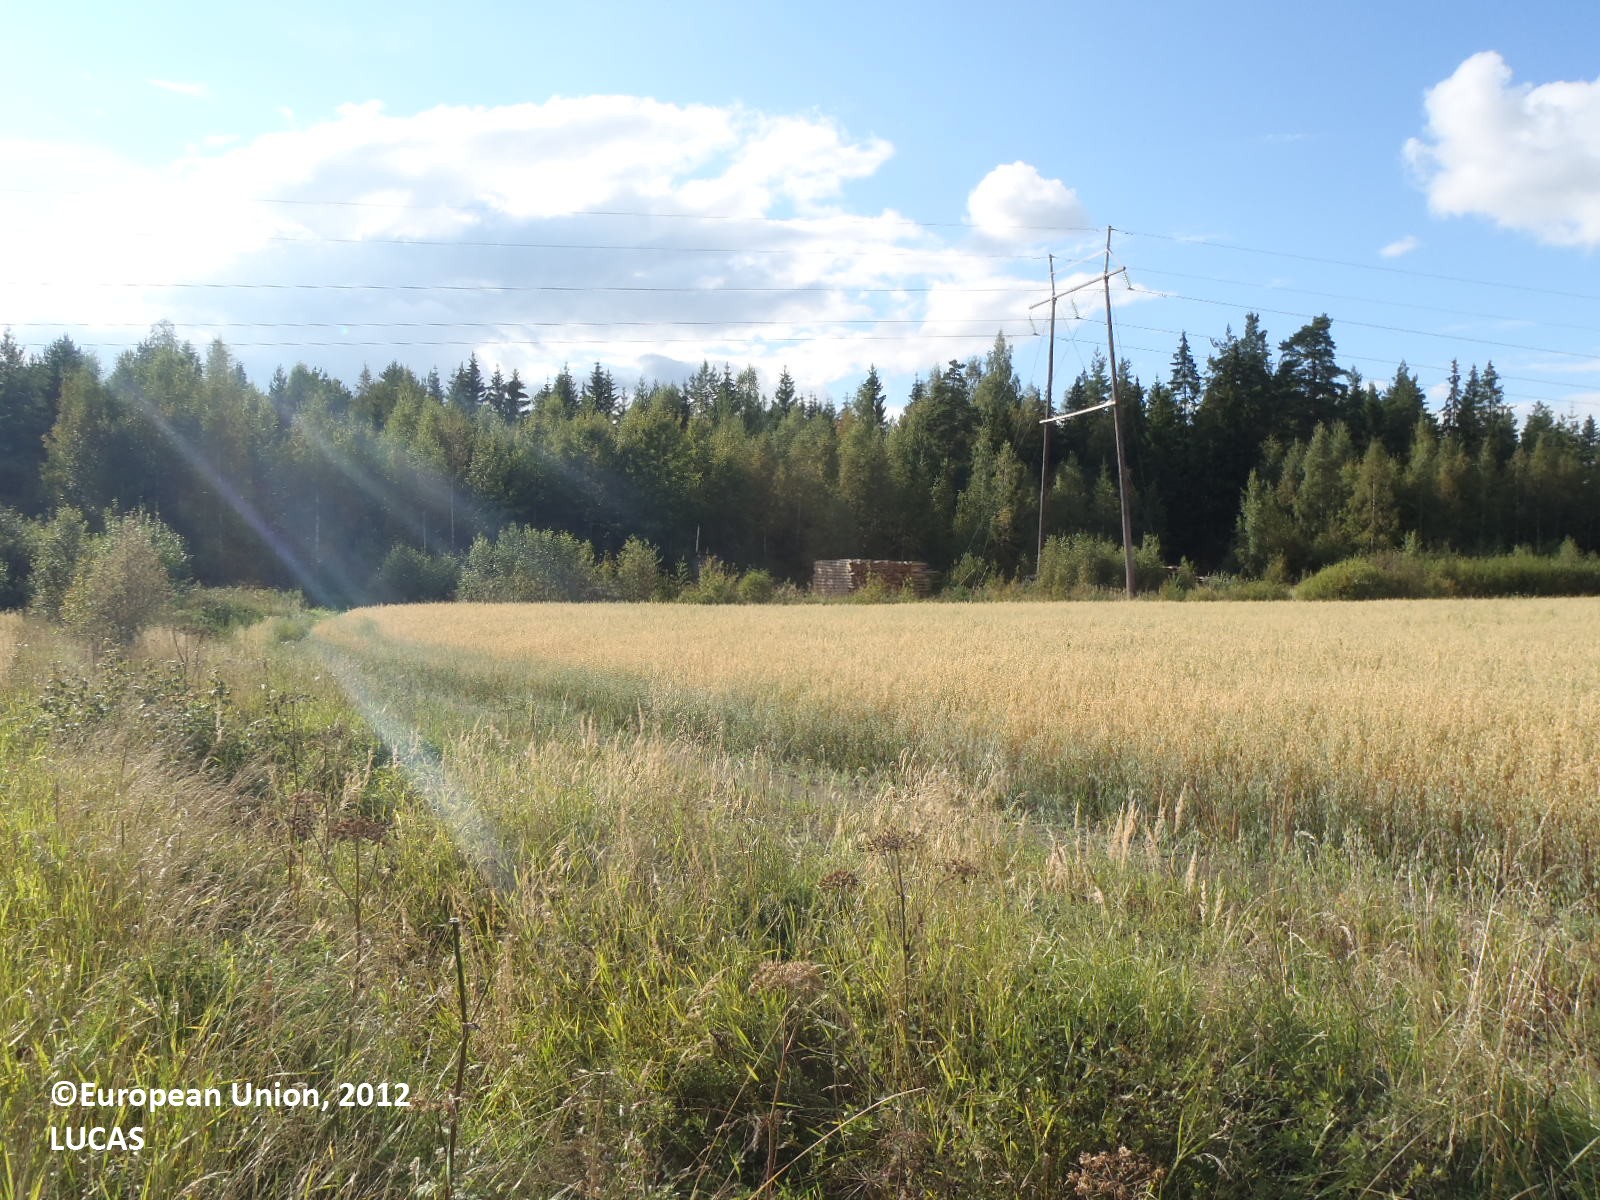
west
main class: Cropland
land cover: Oats
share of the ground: > 75 %
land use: Agriculture (excluding fallow land and kitchen gardens)
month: August
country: FI
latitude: 60.6556
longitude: 22.7874
